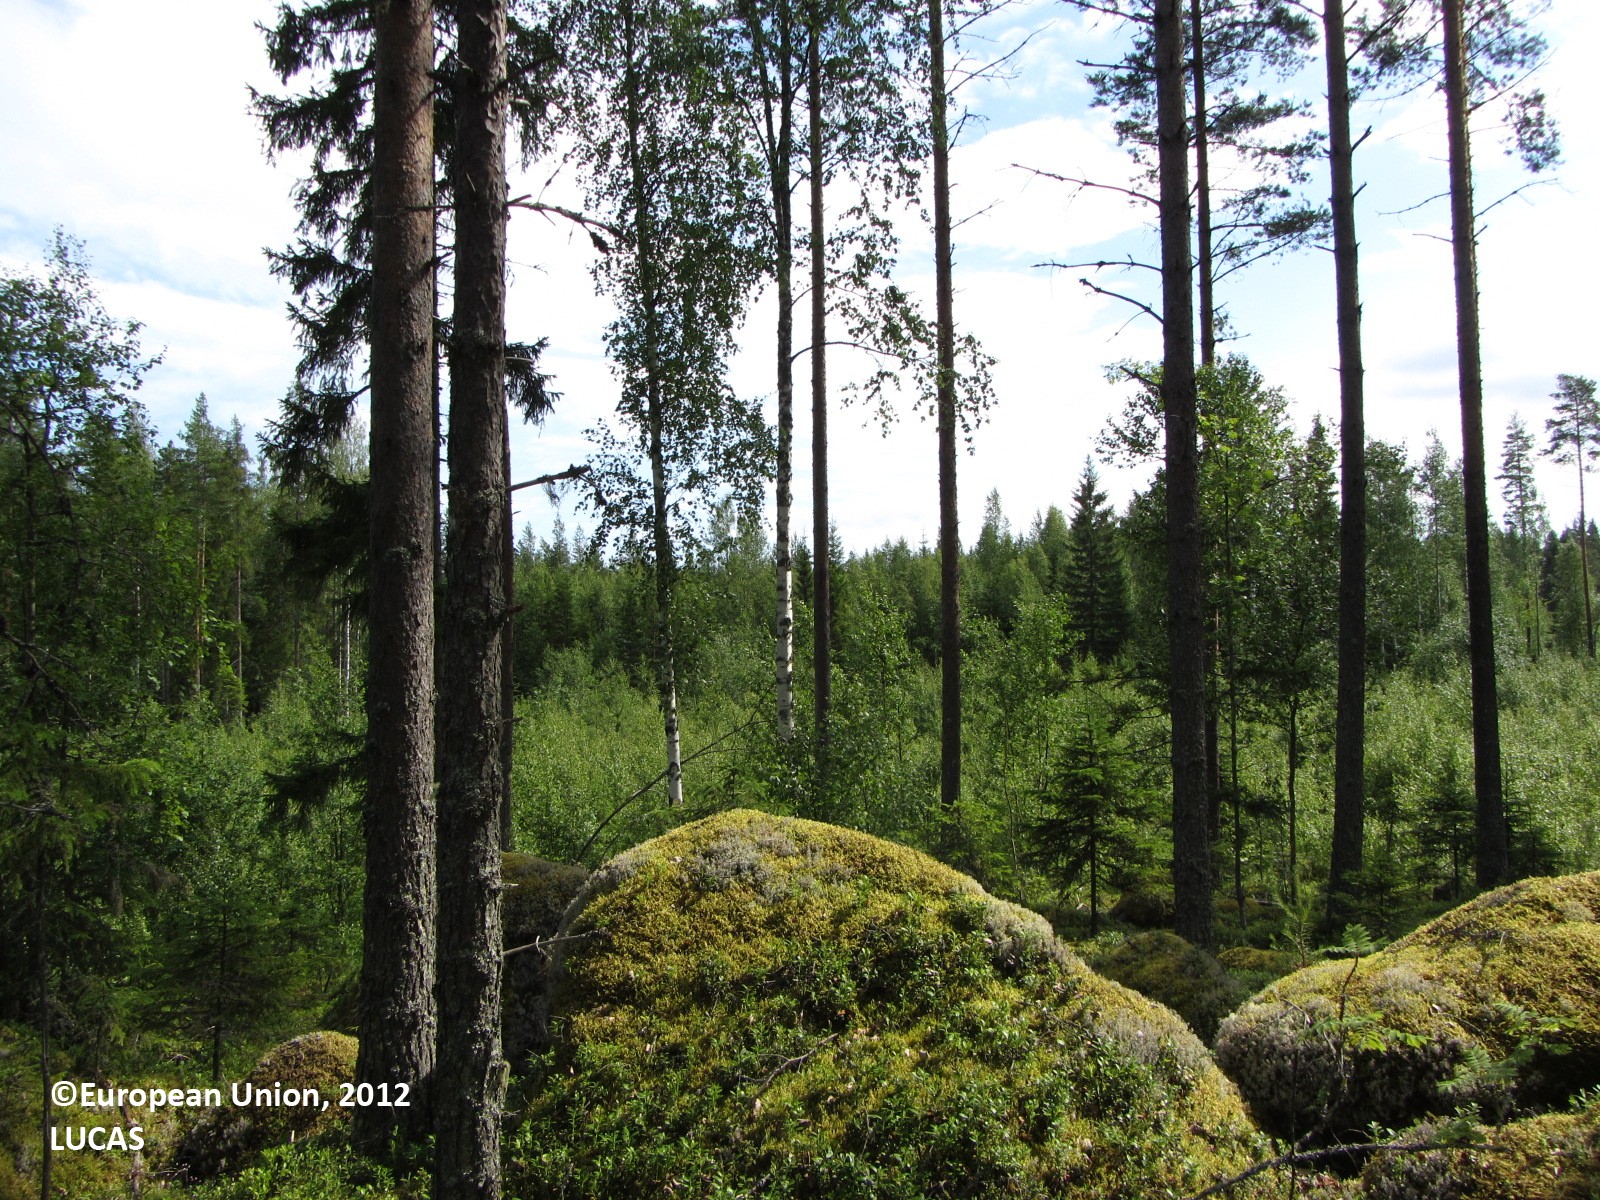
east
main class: Woodland
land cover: Pine dominated coniferous woodland
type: boreal forest
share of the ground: 50 - 75 %
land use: Forestry
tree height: > 5 m
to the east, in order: Pine dominated coniferous woodland; Rock outcrops; Pine dominated coniferous woodland; Broadleaved woodland; Pine dominated coniferous woodland
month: July
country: FI
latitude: 63.6730
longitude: 25.4375
